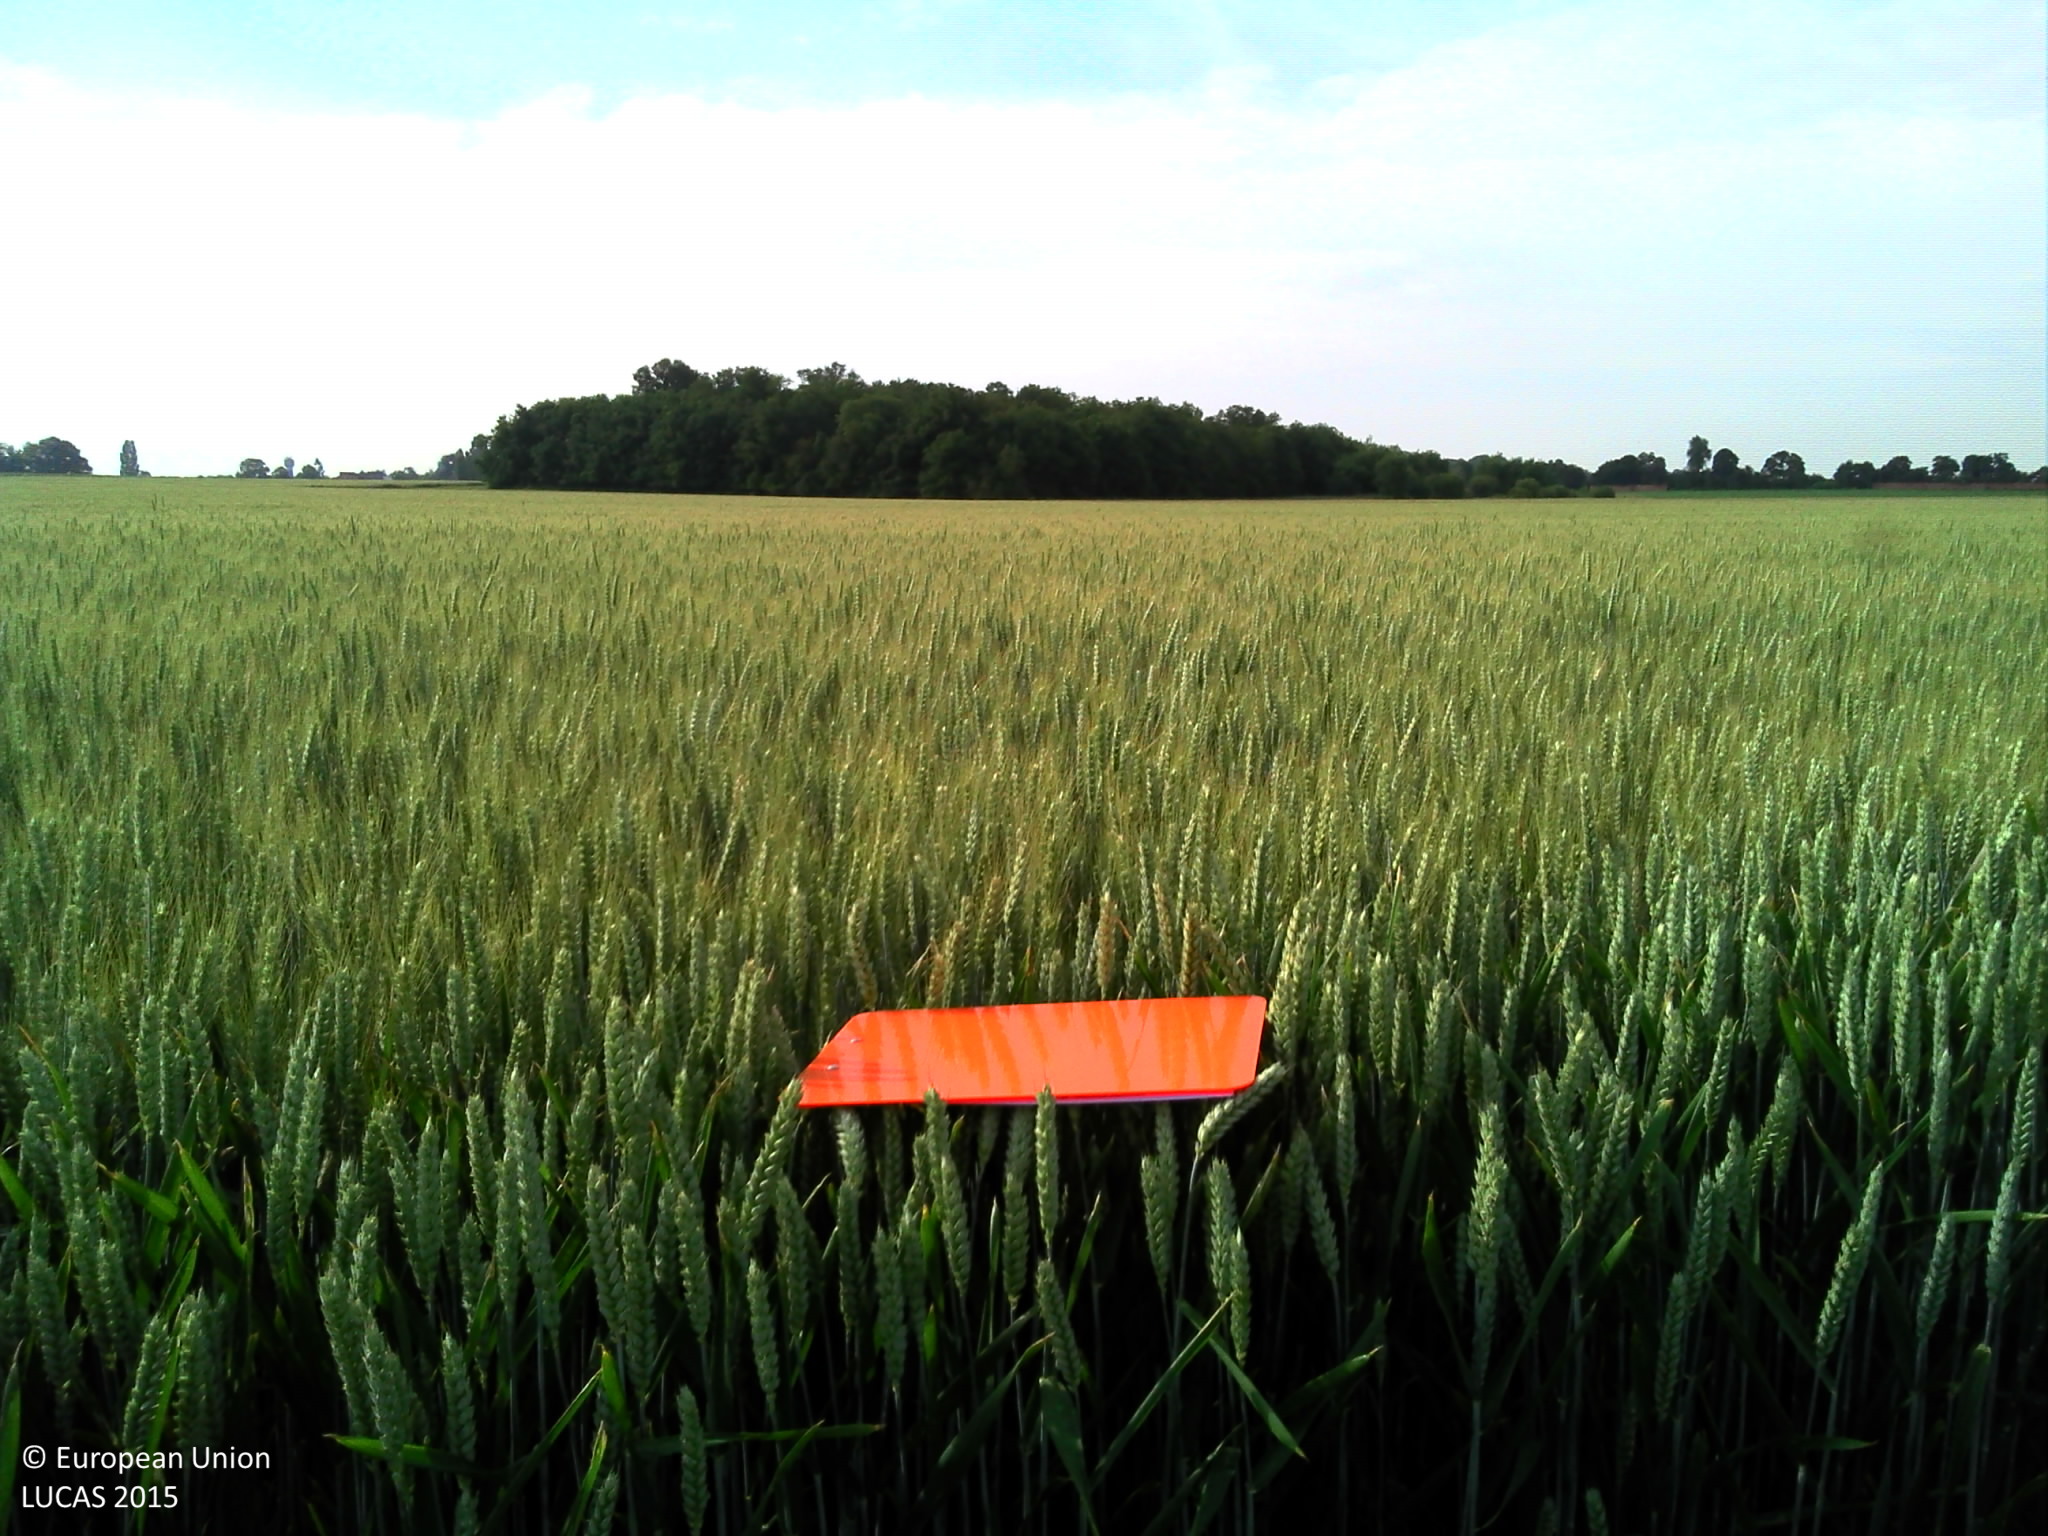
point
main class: Cropland
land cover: Common wheat
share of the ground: > 75 %
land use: Agriculture (excluding fallow land and kitchen gardens)
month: June
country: FR
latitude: 48.2891
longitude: 1.4518
